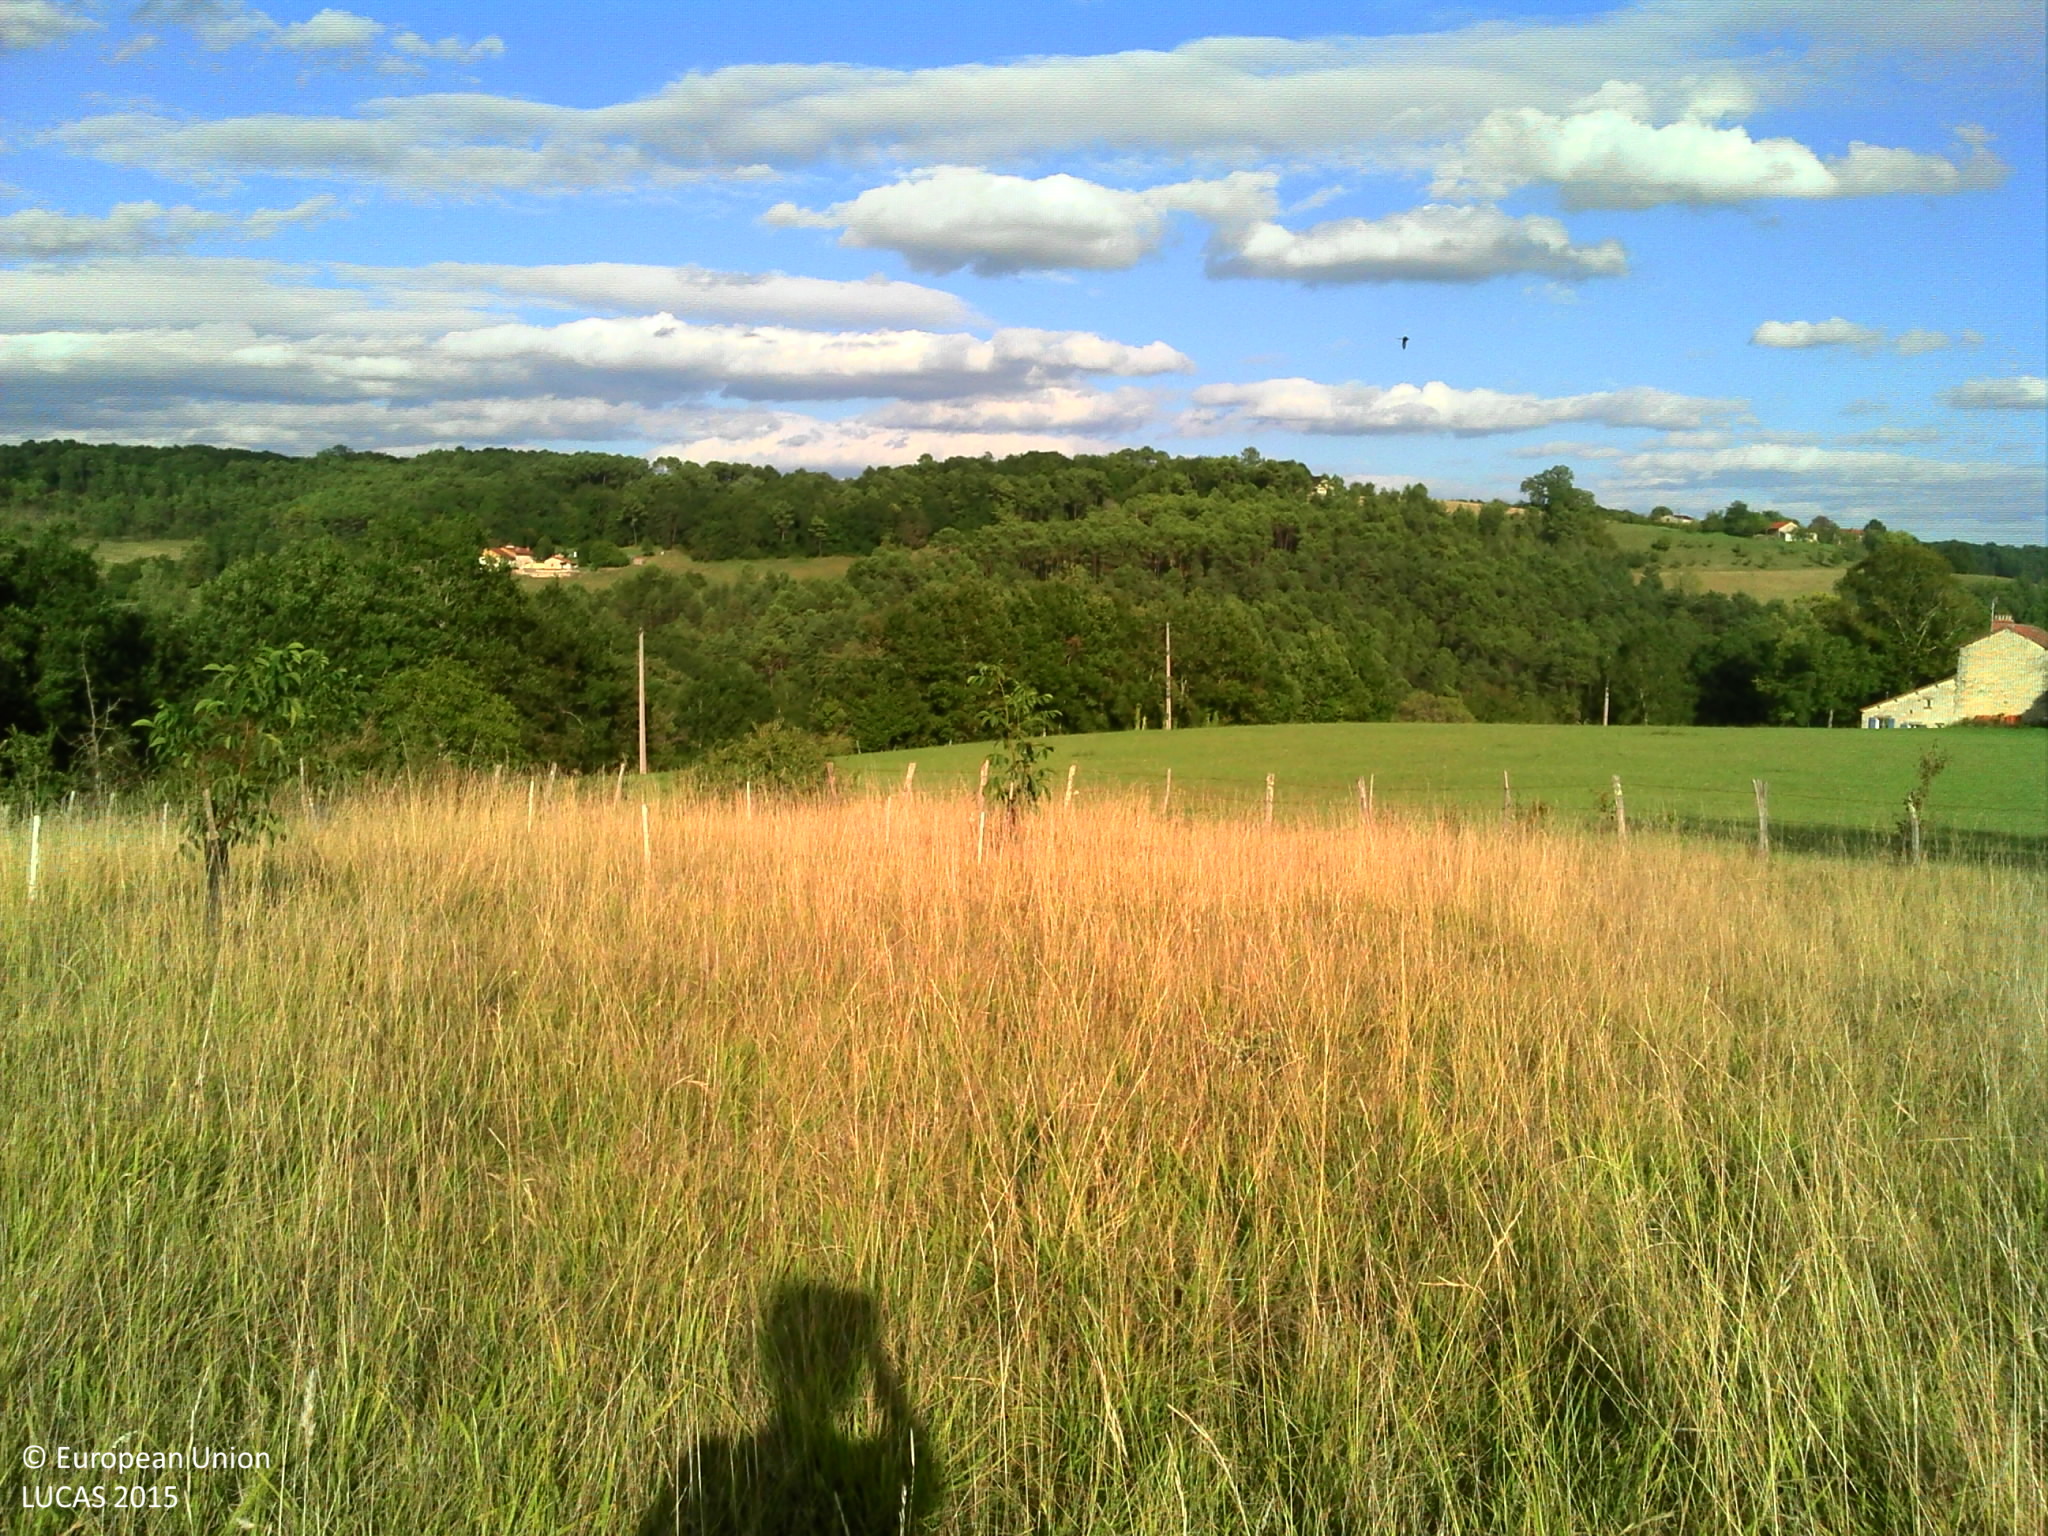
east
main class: Grassland
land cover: Grassland without tree/shrub cover
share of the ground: > 75 %
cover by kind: herbaceous plants 90 %, lichens and mosses 10 %
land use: Agriculture (excluding fallow land and kitchen gardens)
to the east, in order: Grassland without tree/shrub cover; Fences; Grassland without tree/shrub cover; Fences; Electric lines; Tracks; Abandoned hedges; Spontaneously vegetated surfaces; Sunflower
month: August
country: FR
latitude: 45.1869
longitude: 0.5324
